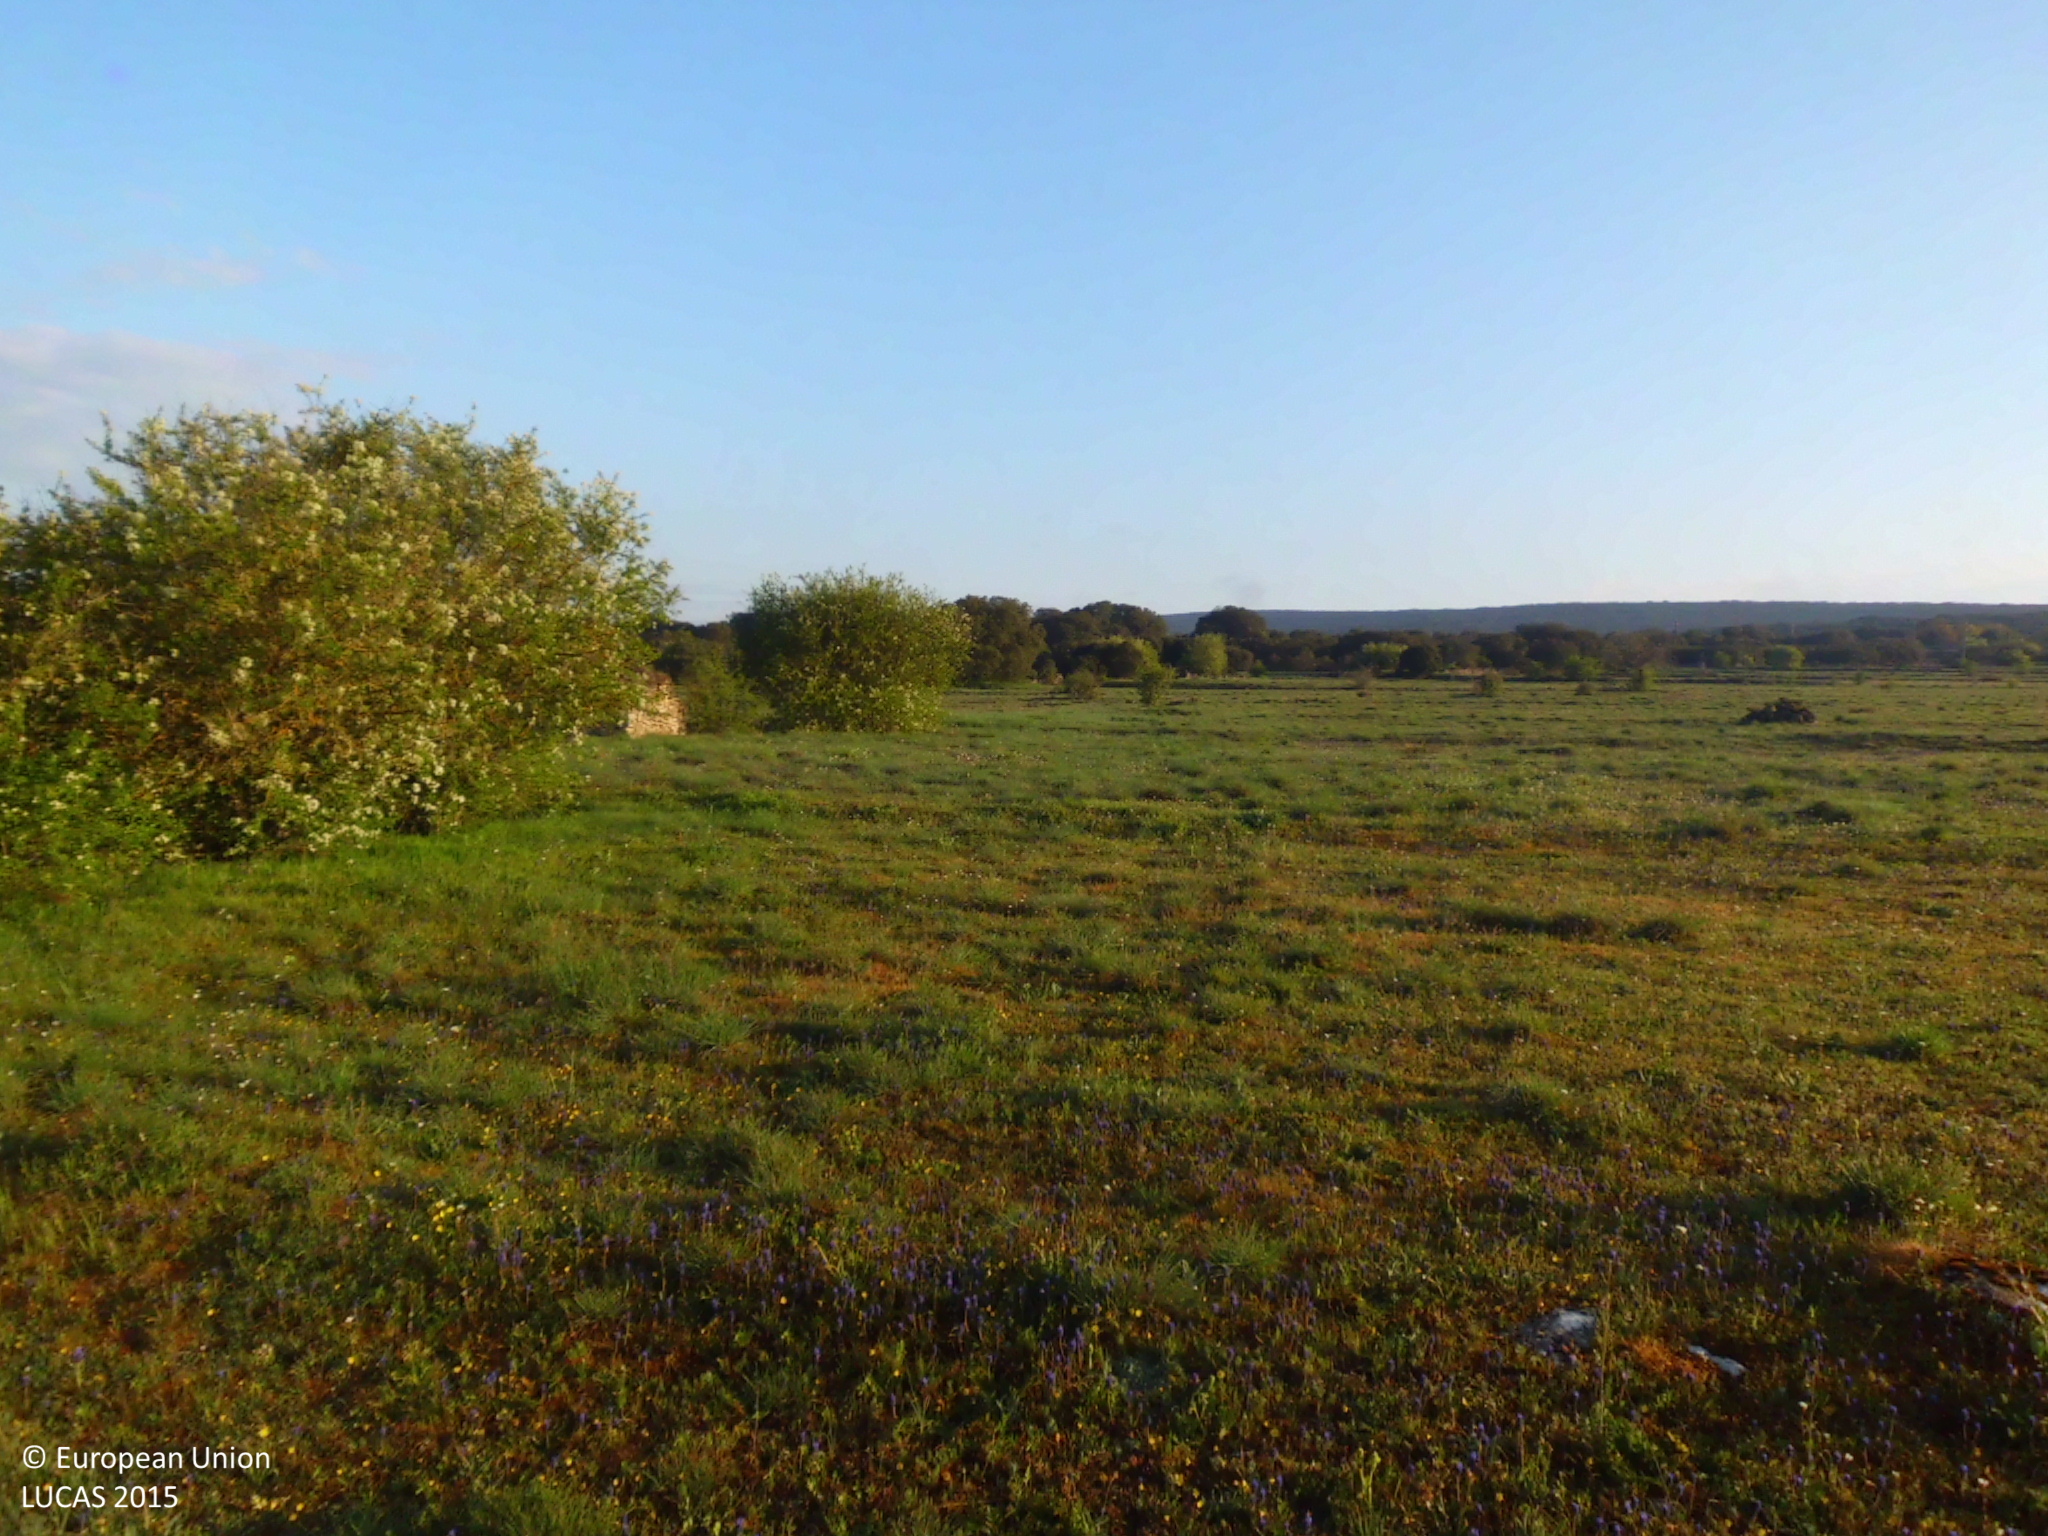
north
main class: Grassland
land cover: Grassland without tree/shrub cover
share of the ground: > 75 %
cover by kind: herbaceous plants 95 %, shrubs 5 %
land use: Abandoned areas
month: April
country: ES
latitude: 42.8407
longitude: -3.7828
